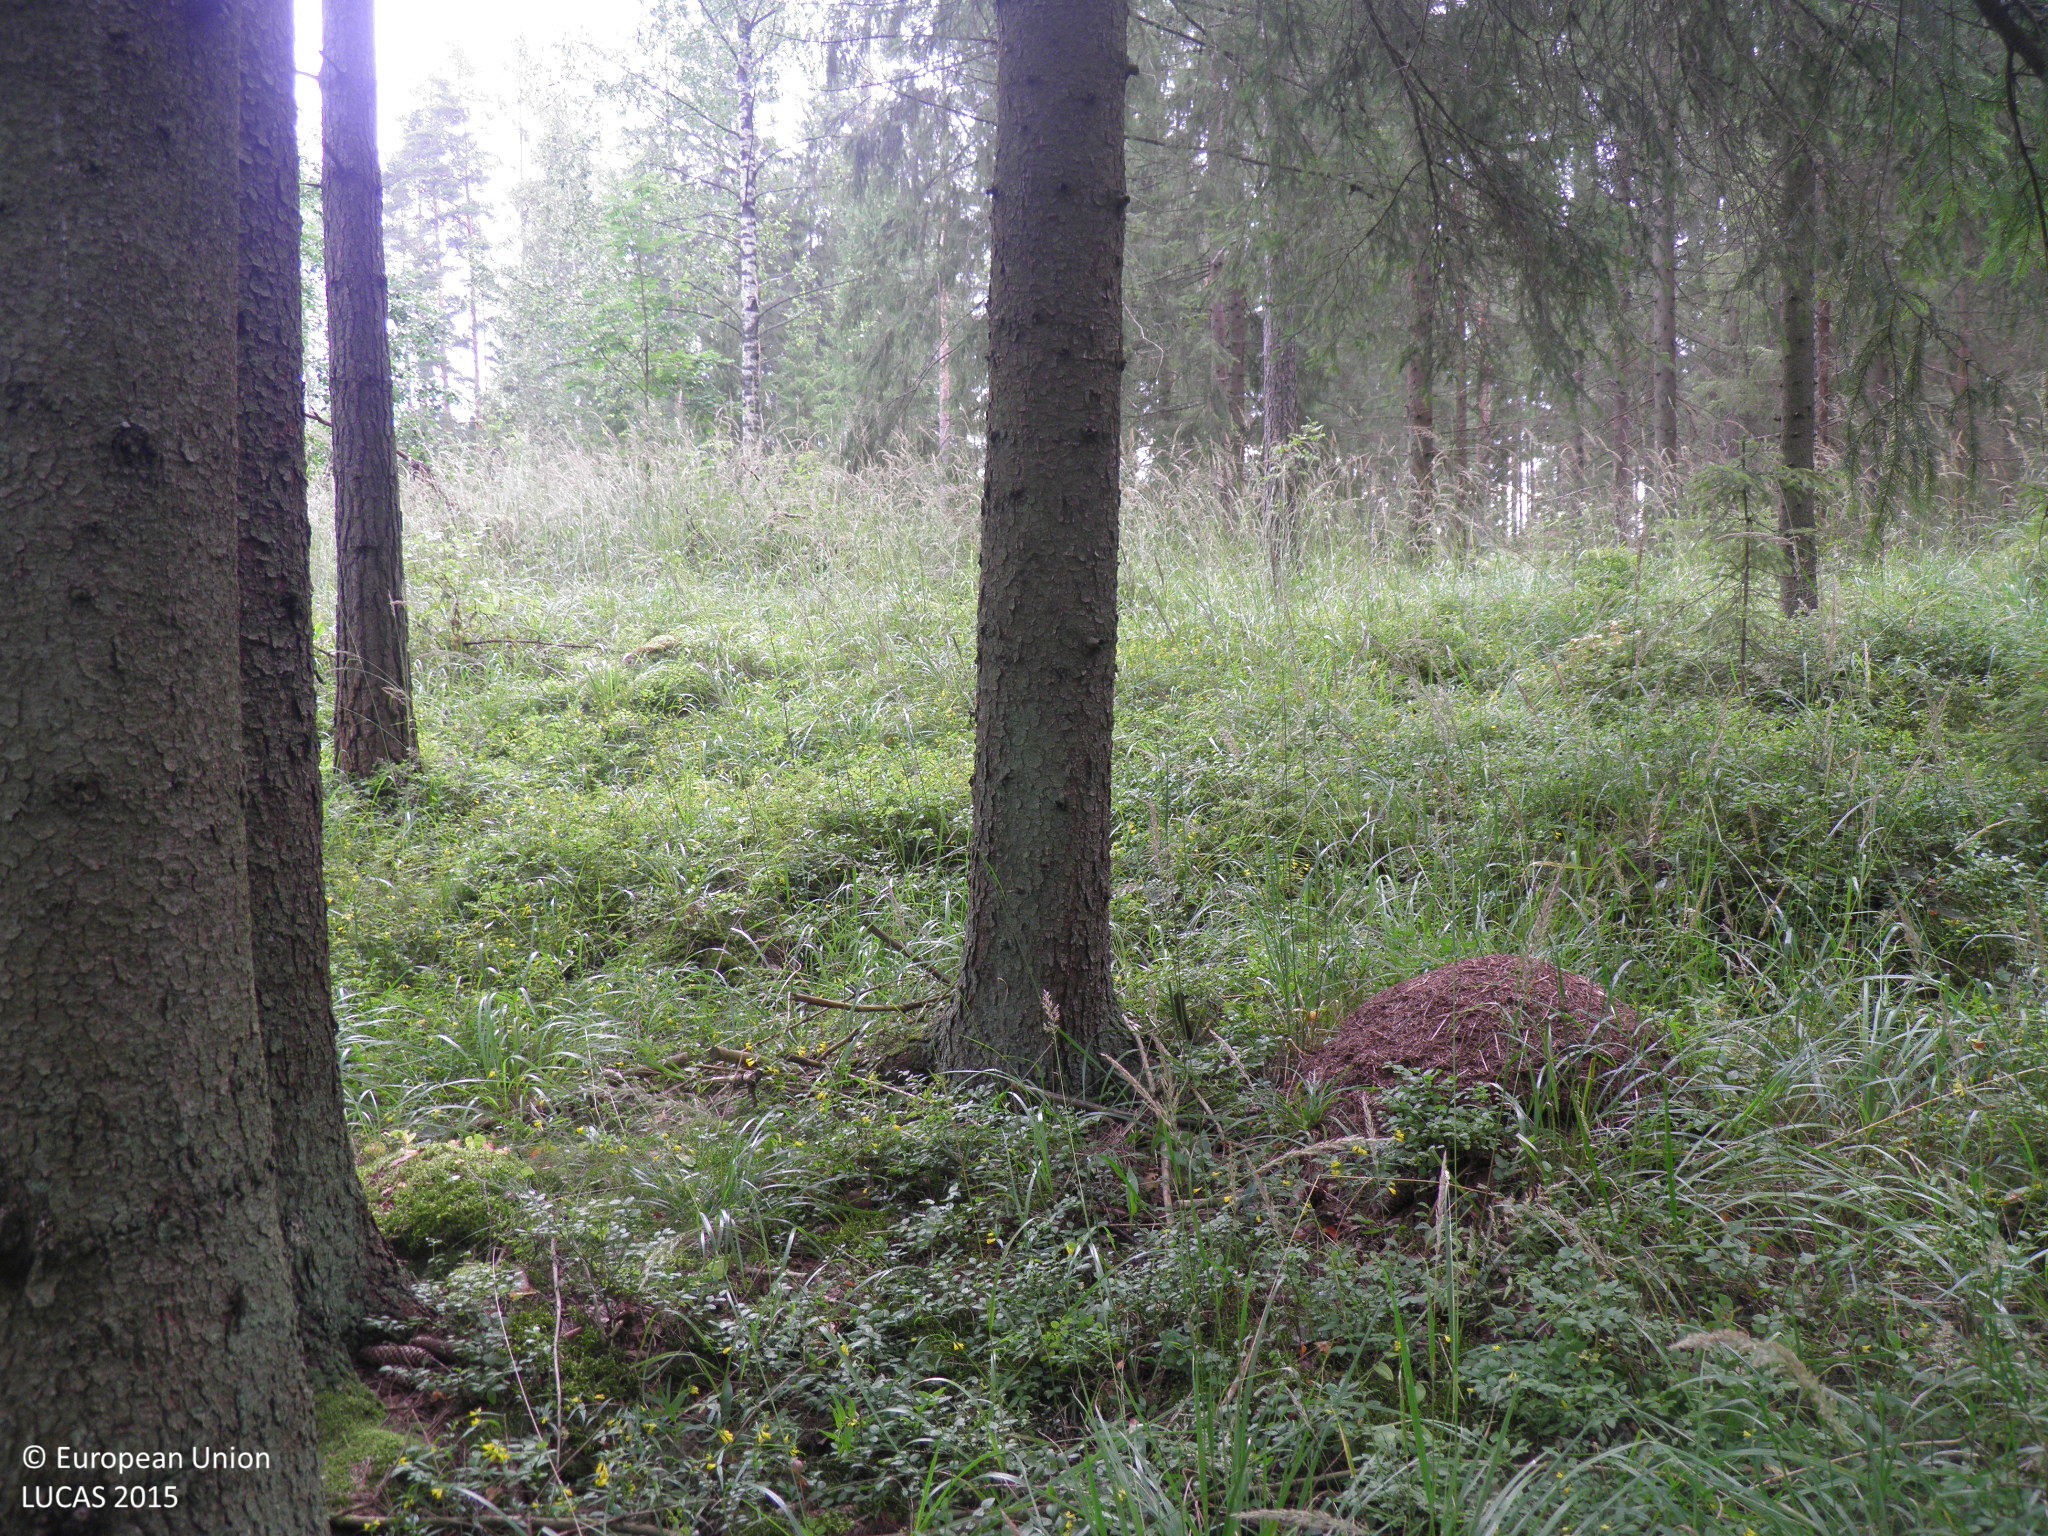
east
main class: Woodland
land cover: Spruce dominated coniferous woodland
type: hemiboreal forest and nemoral coniferous forest and mixed broadleaved-coniferous forest
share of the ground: > 75 %
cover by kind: coniferous forest trees 70 %, shrubs 10 %, herbaceous plants 10 %, broadleaved forest trees 5 %, lichens and mosses 5 %
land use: Forestry
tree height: > 5 m
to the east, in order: Spruce dominated coniferous woodland; Ditches and canals; Spruce dominated coniferous woodland; Tracks; Spruce dominated coniferous woodland; Tracks; Spruce dominated mixed woodland; Paved roads, cycling and walking lanes; Grass margins; Ditches and canals; Common wheat
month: August
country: FI
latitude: 60.8498
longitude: 22.4532
